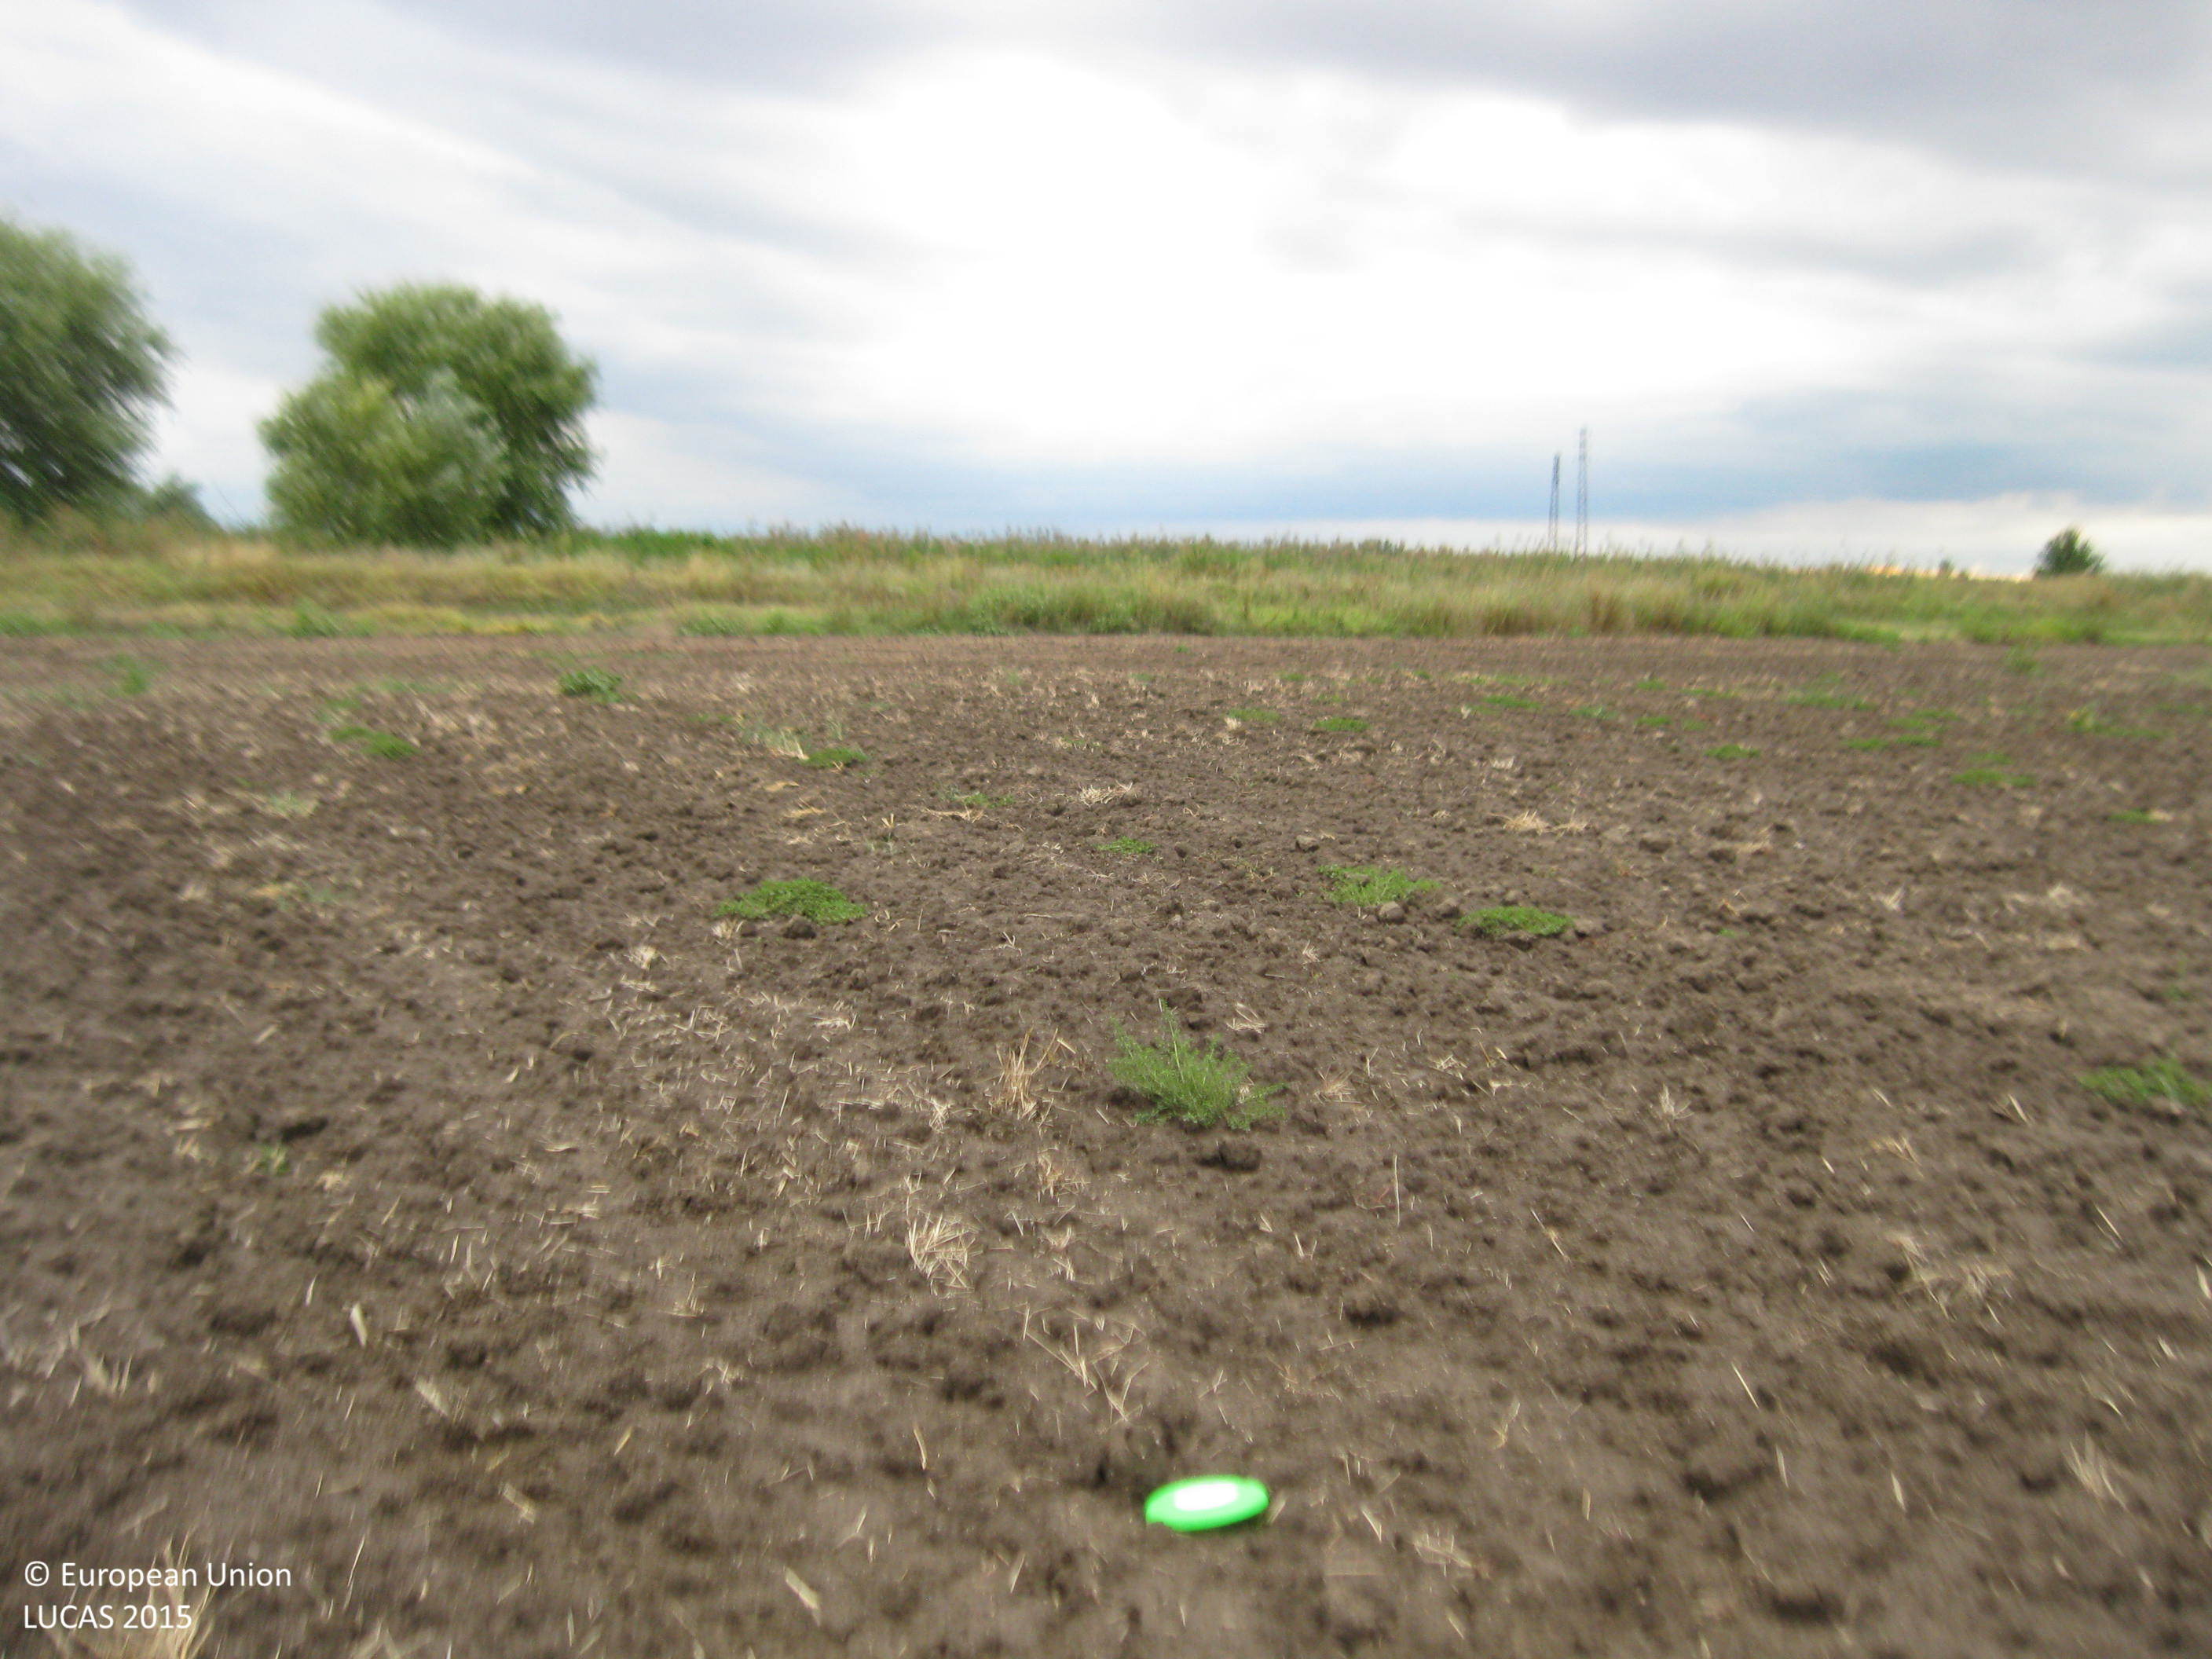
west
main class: Cropland
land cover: Common wheat
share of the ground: < 10 %
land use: Agriculture (excluding fallow land and kitchen gardens)
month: August
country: BG
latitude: 42.2096
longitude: 24.7447
